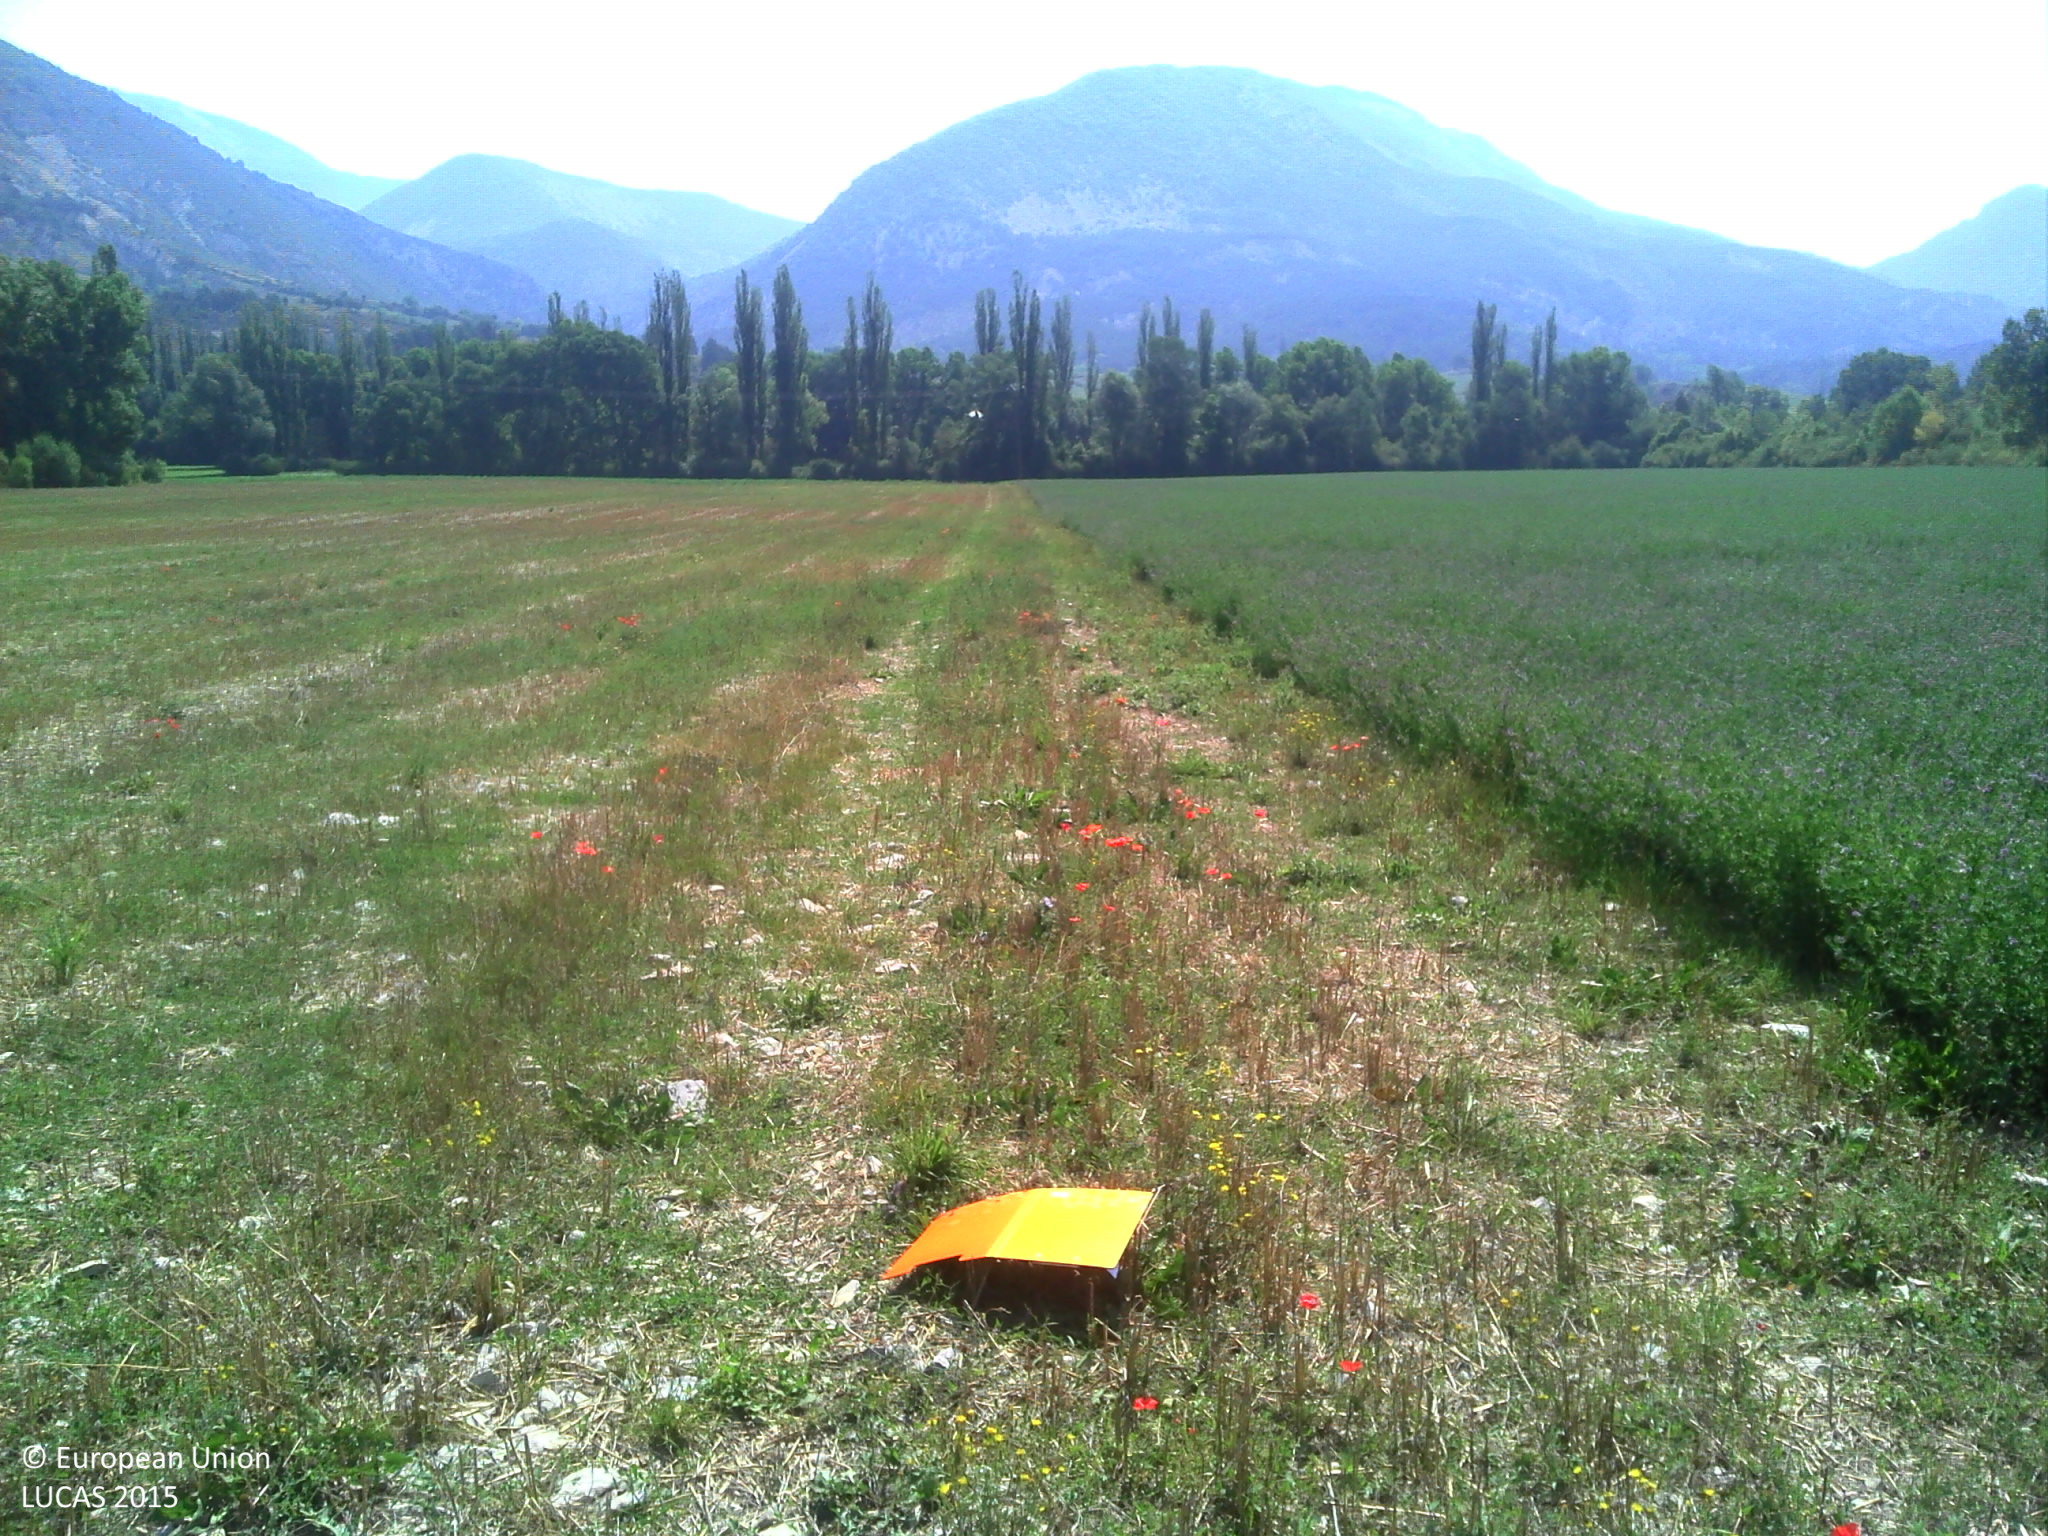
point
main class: Grassland
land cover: Spontaneously vegetated surfaces
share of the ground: > 75 %
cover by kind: herbaceous plants 100 %
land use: Agriculture (excluding fallow land and kitchen gardens)
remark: Harvested field
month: August
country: FR
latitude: 44.0165
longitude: 6.3775
